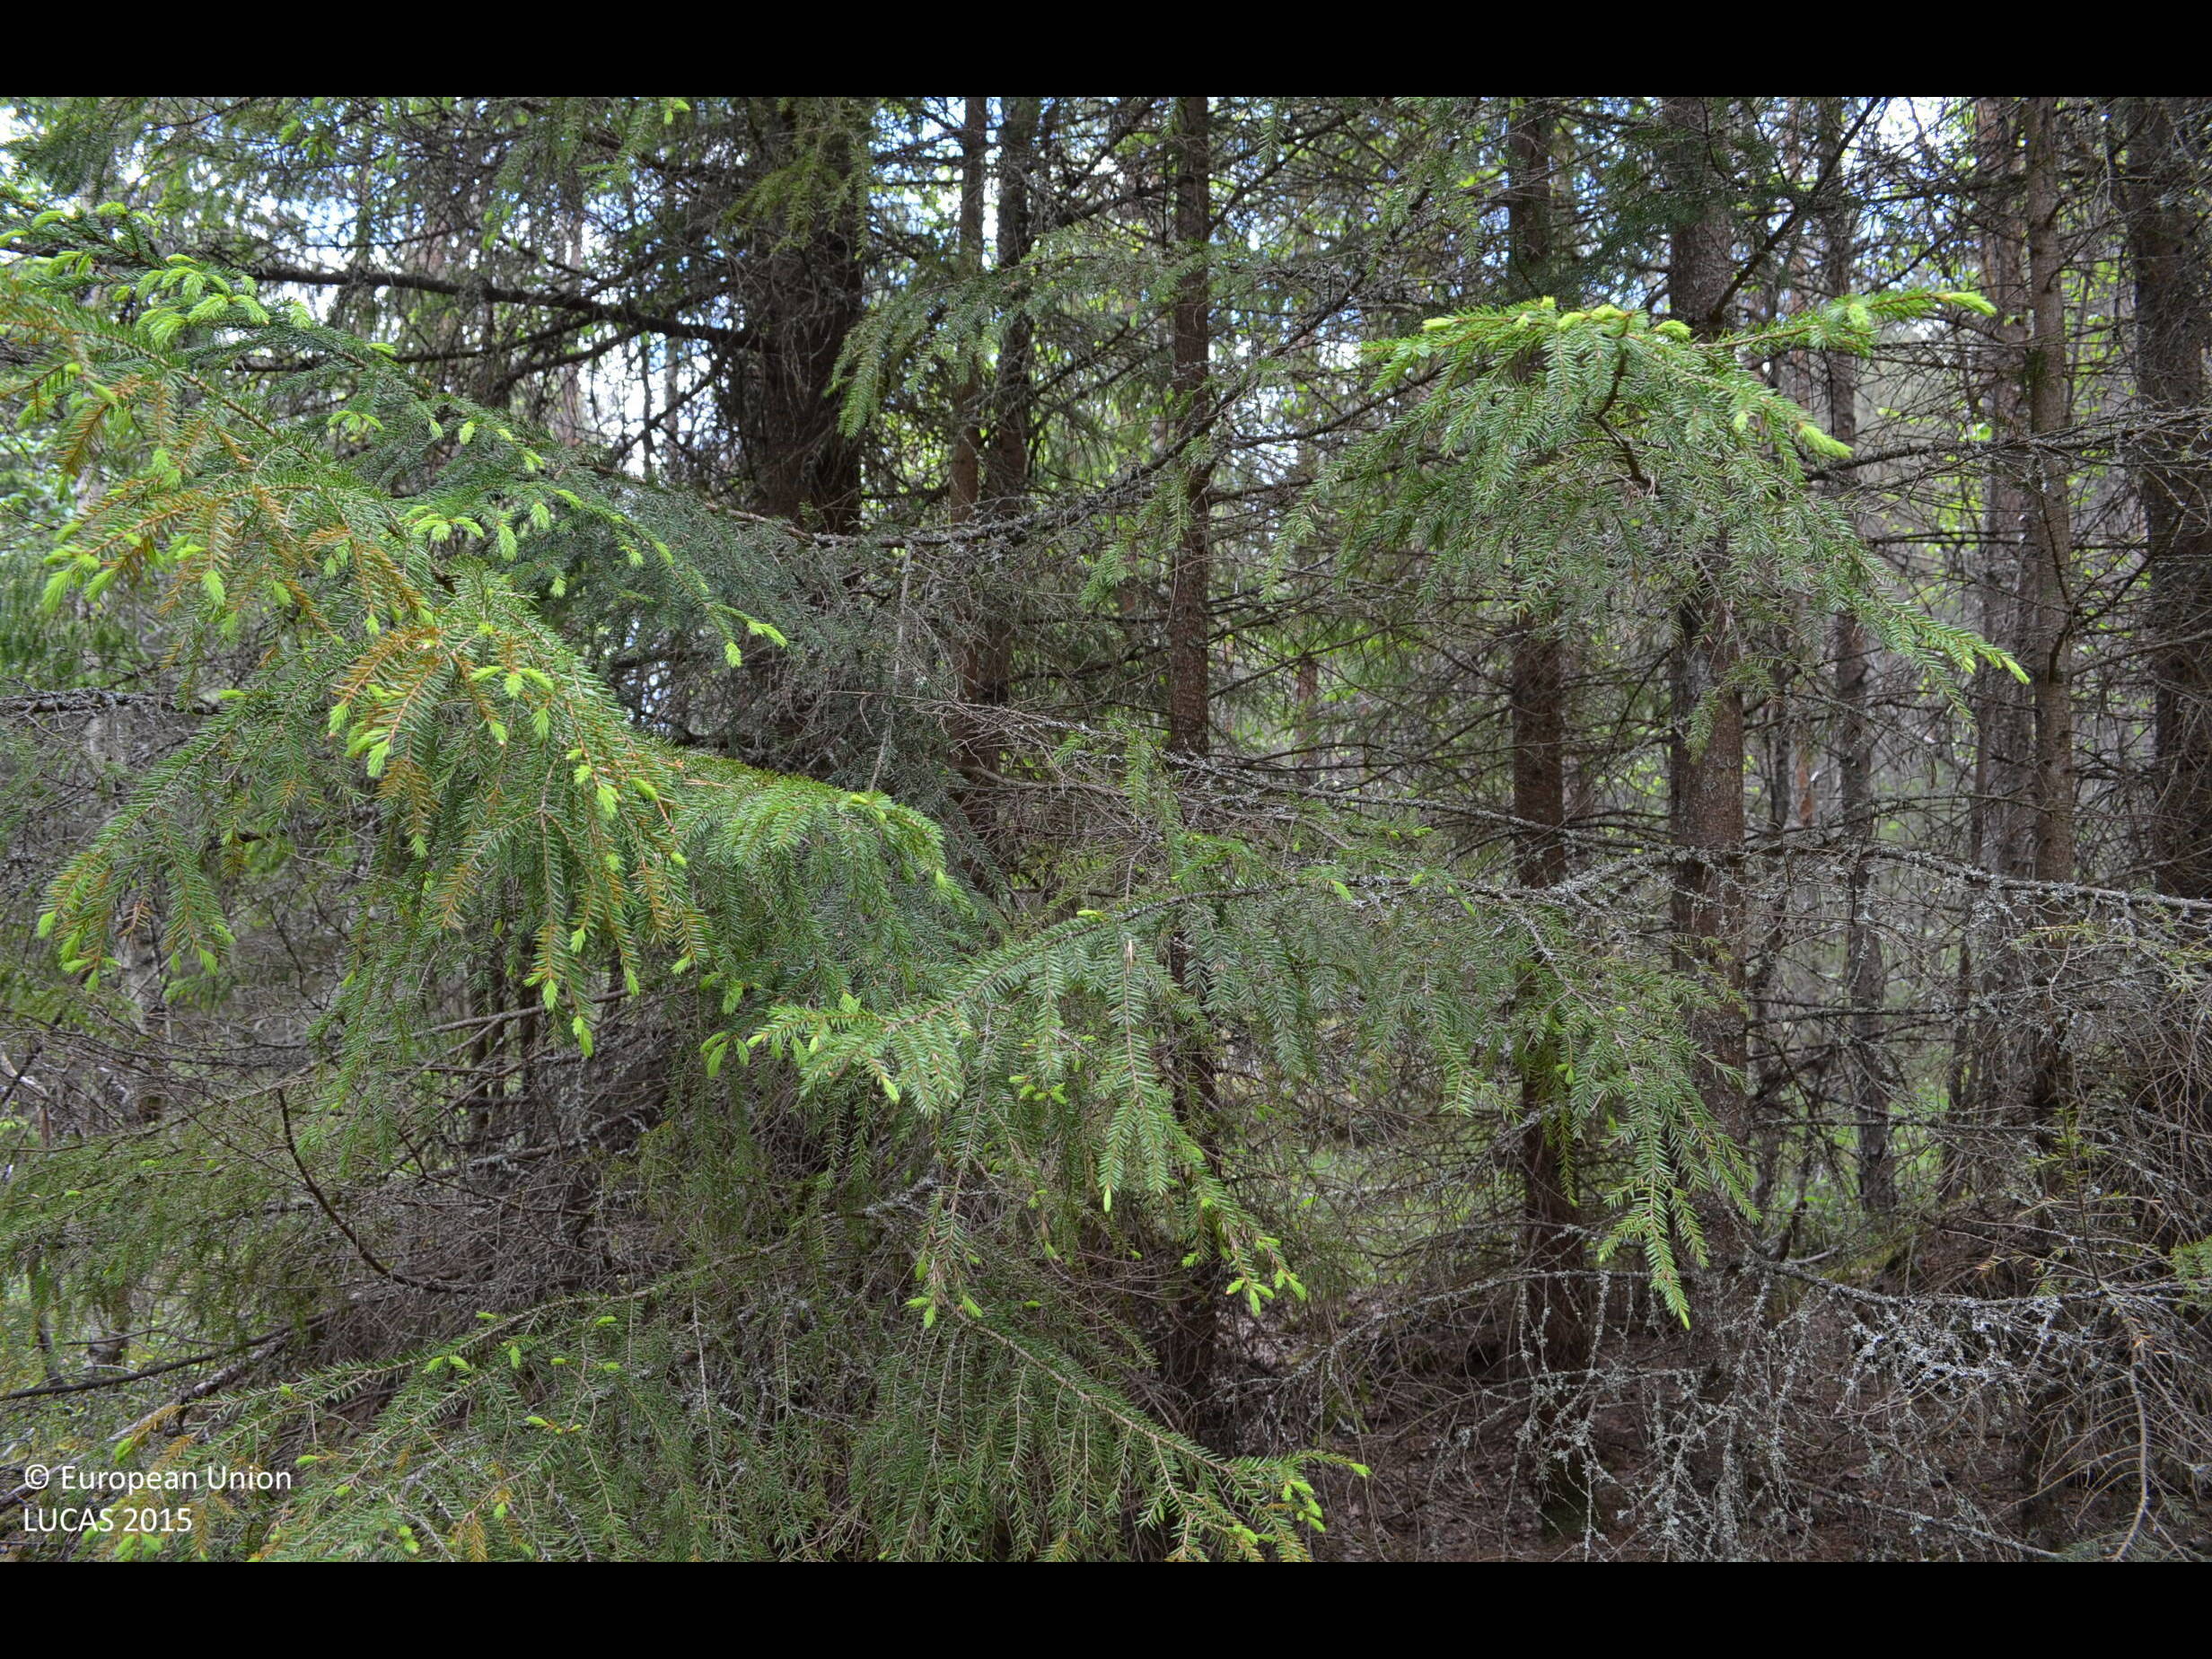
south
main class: Woodland
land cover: Other mixed woodland
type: boreal forest
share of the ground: > 75 %
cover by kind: coniferous forest trees 65 %, broadleaved forest trees 25 %, shrubs 5 %, herbaceous plants 5 %
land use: Forestry
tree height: > 5 m
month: June
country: FI
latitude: 61.9650
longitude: 23.2889
